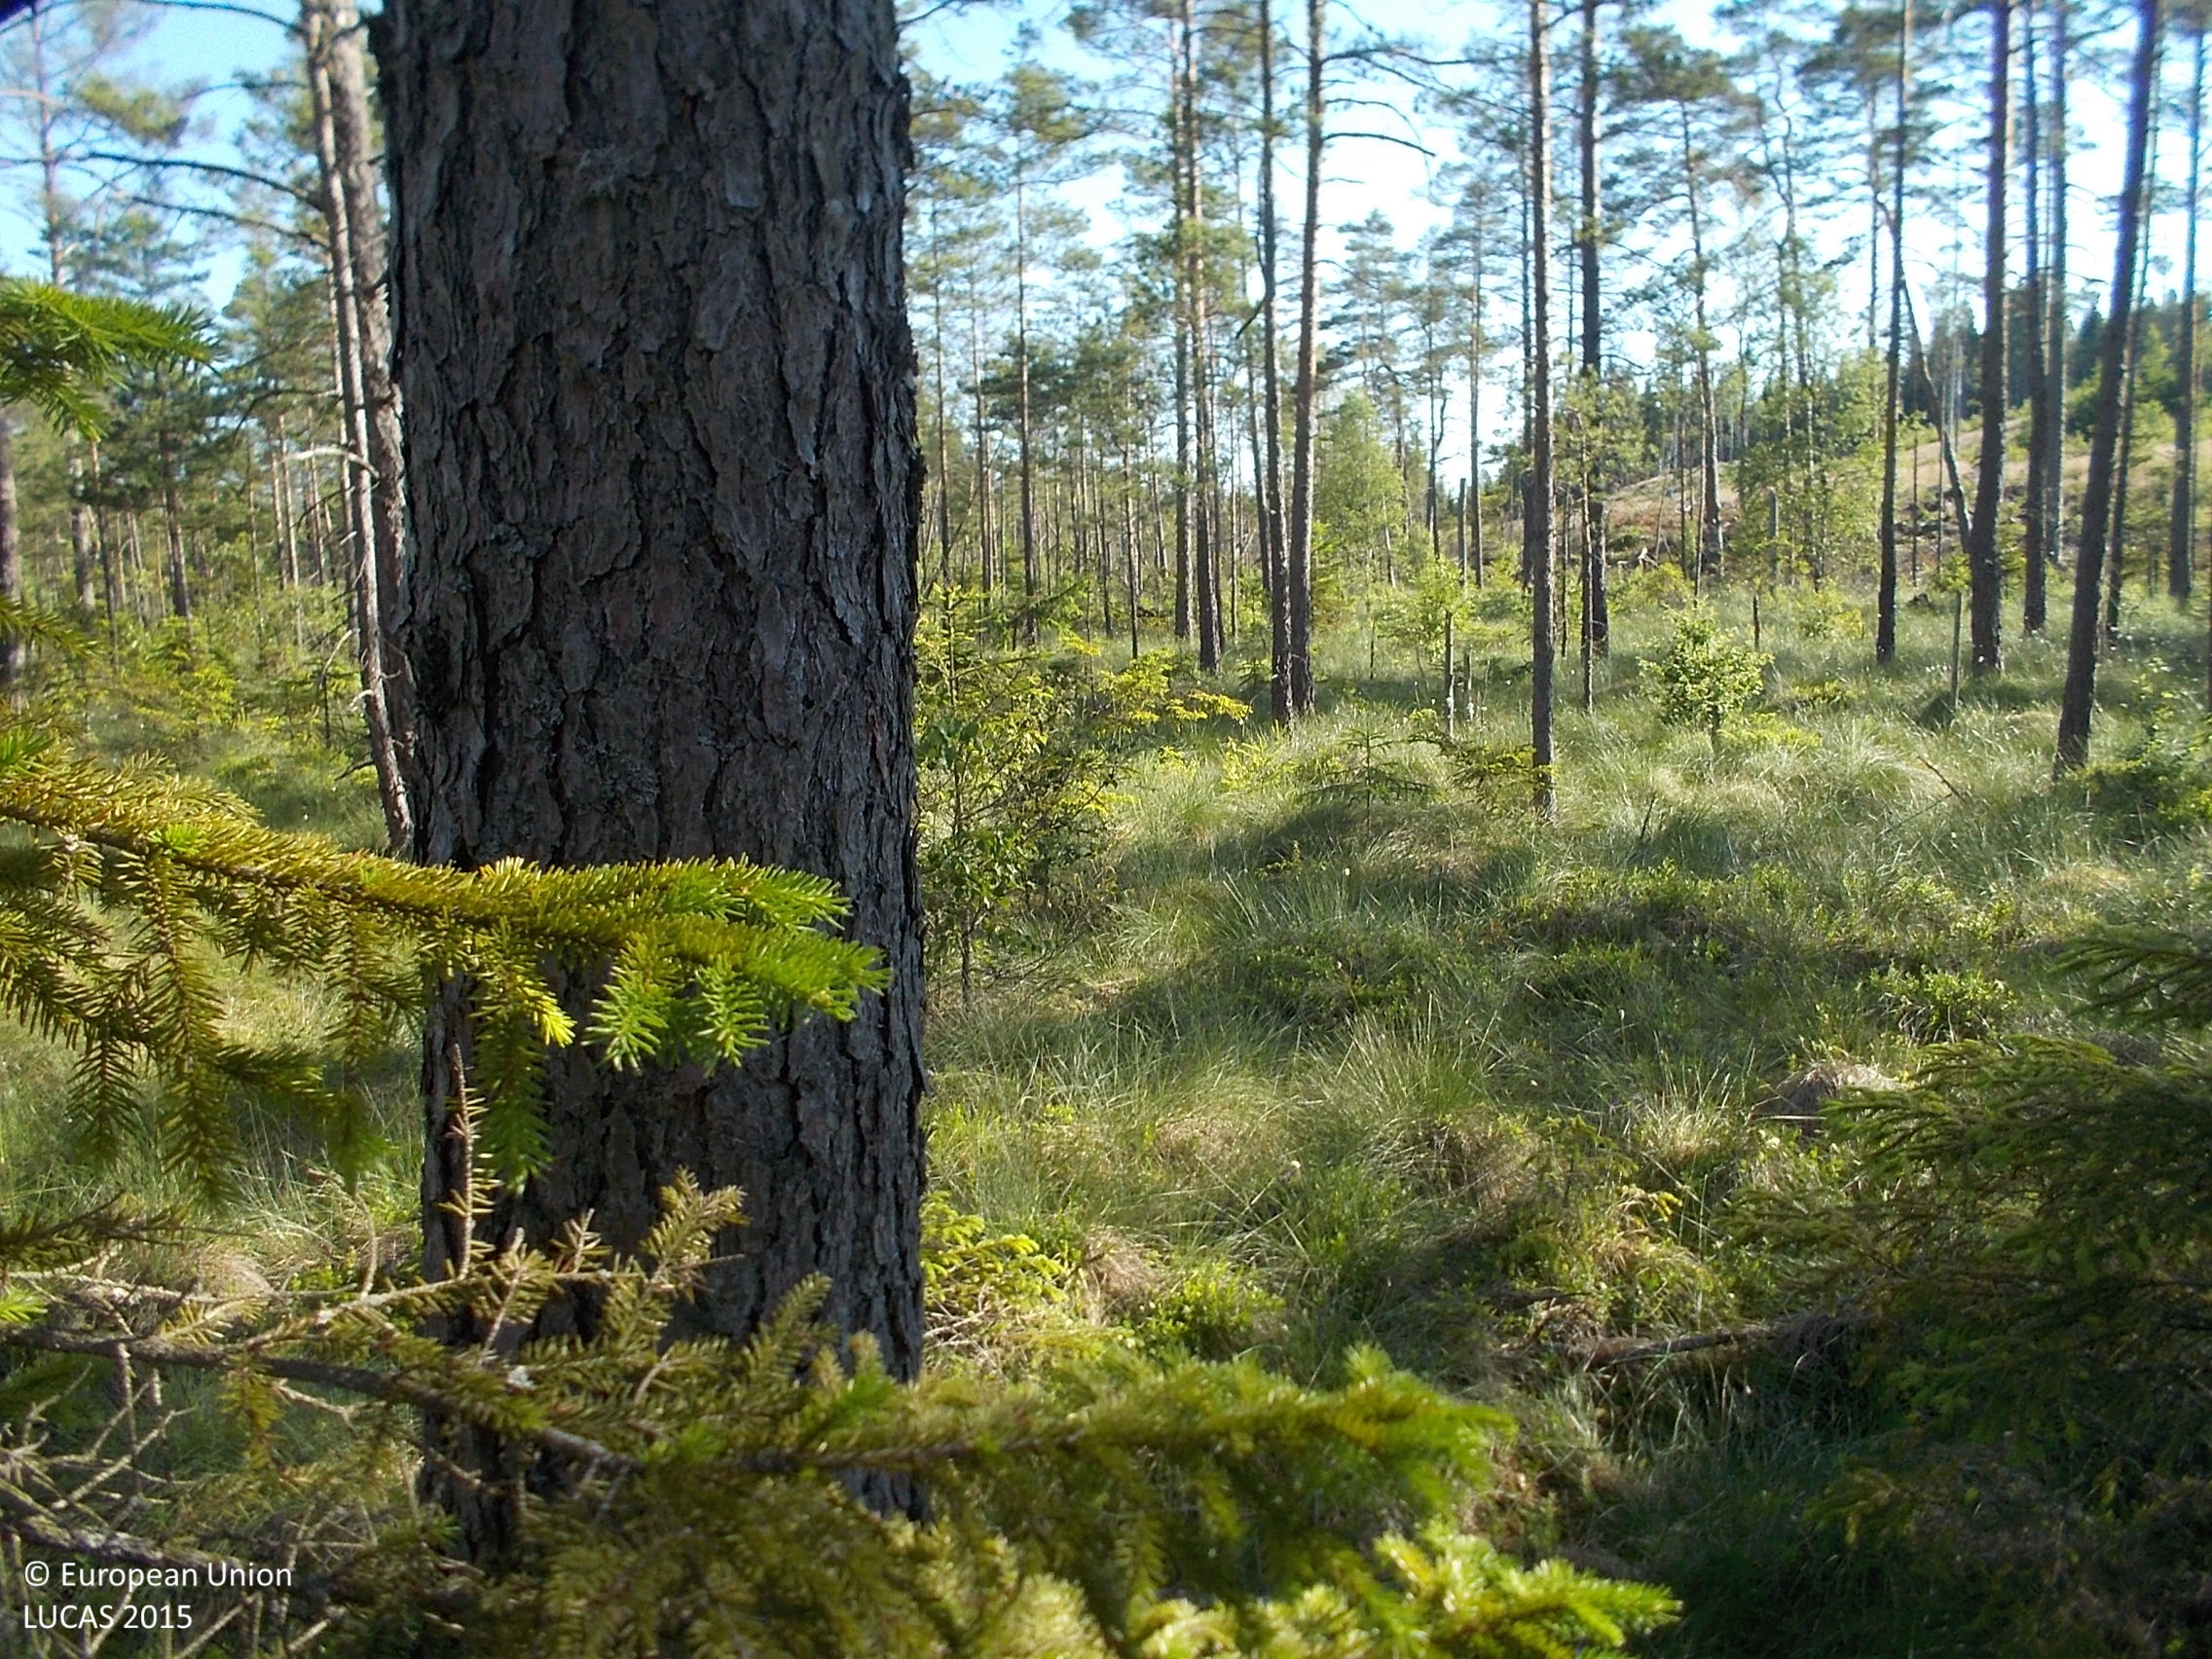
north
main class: Woodland
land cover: Pine dominated coniferous woodland
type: boreal forest
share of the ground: 50 - 75 %
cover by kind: coniferous forest trees 60 %, herbaceous plants 35 %, lichens and mosses 5 %
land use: Forestry
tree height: > 5 m
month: July
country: SE
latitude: 57.2465
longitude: 13.1614
